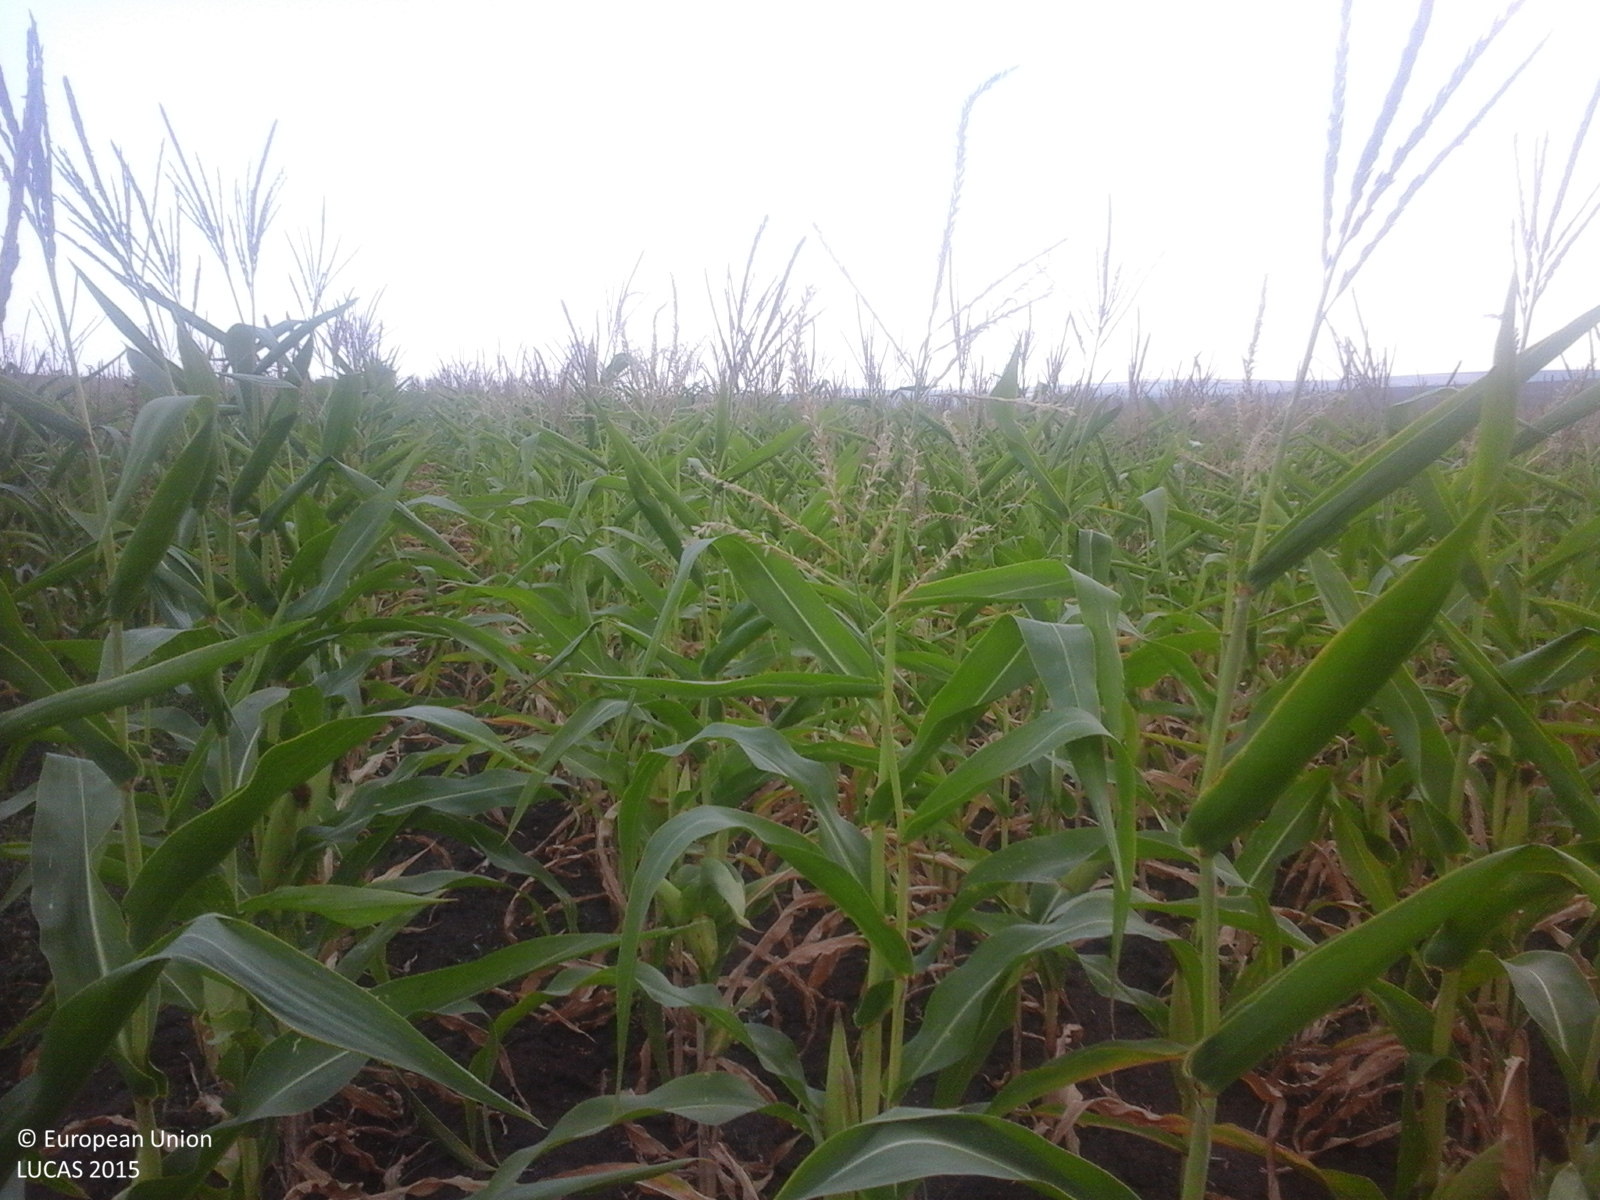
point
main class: Cropland
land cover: Maize
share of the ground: > 75 %
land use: Agriculture (excluding fallow land and kitchen gardens)
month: July
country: RO
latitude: 45.8220
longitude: 27.9987
